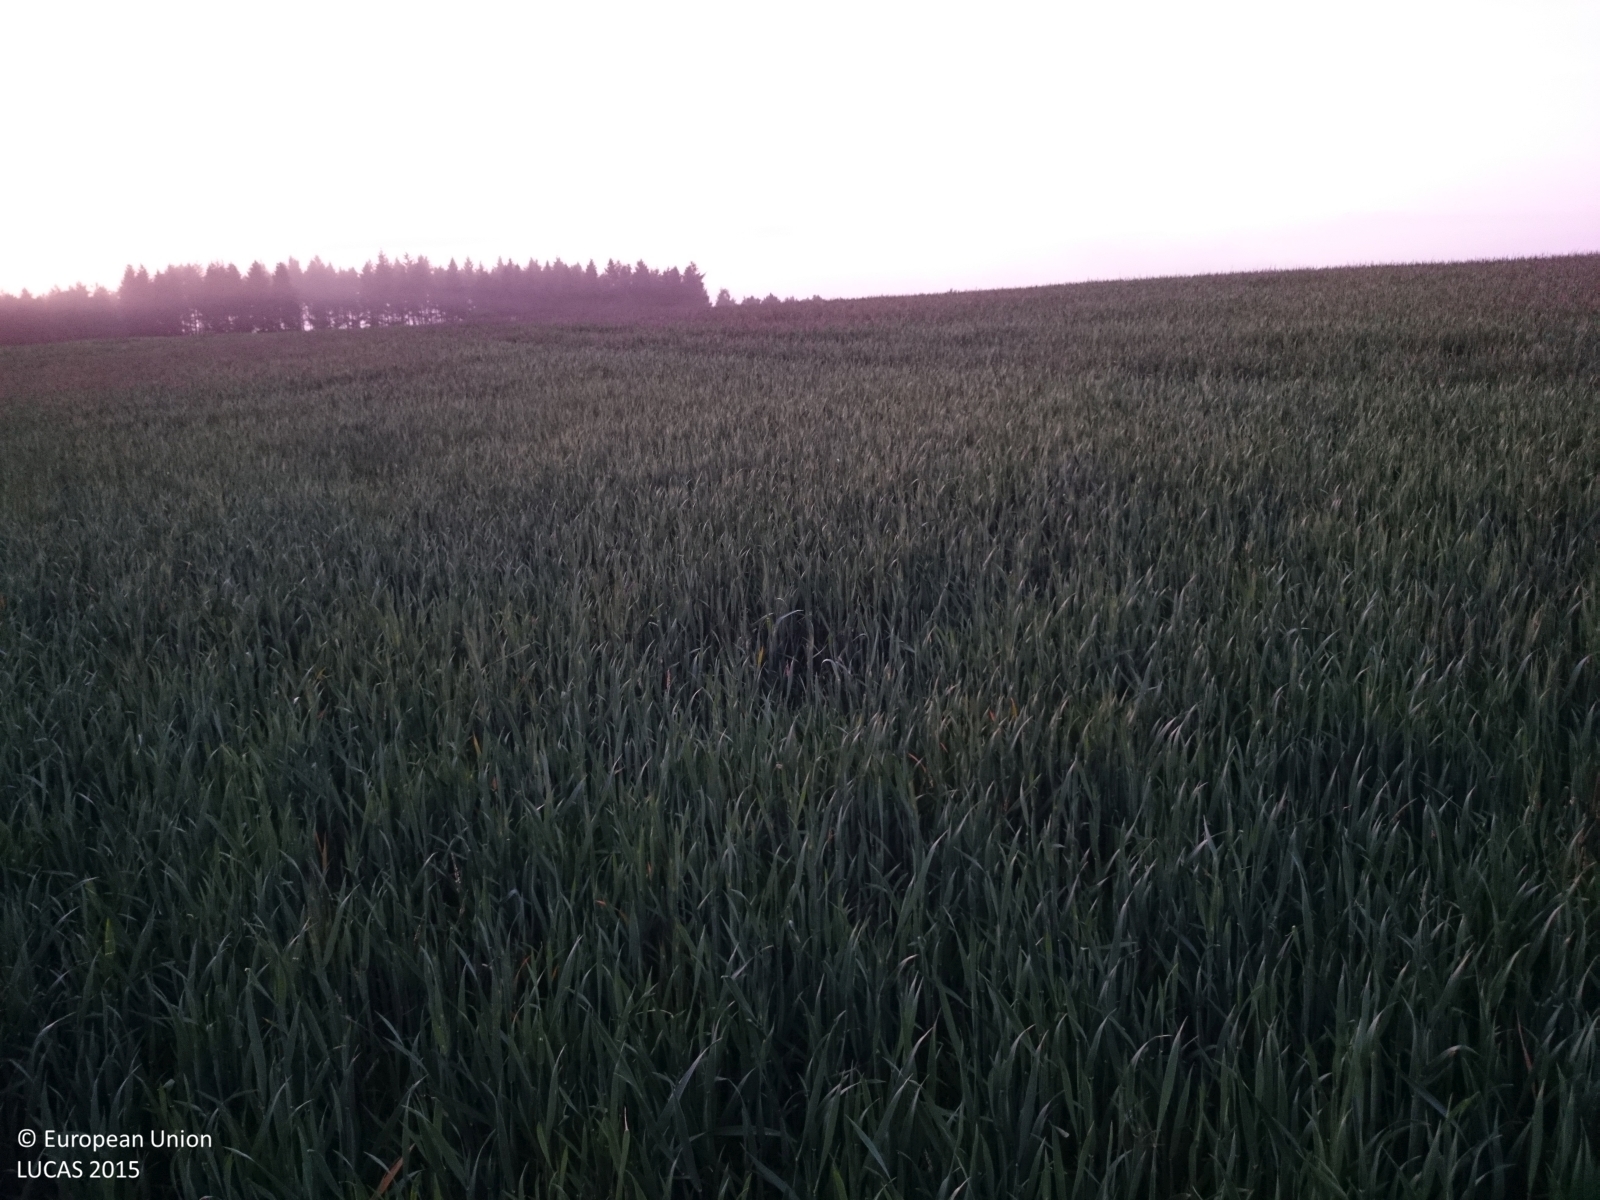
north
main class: Cropland
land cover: Barley
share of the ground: > 75 %
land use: Agriculture (excluding fallow land and kitchen gardens)
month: May
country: PL
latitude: 52.5671
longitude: 15.6549
